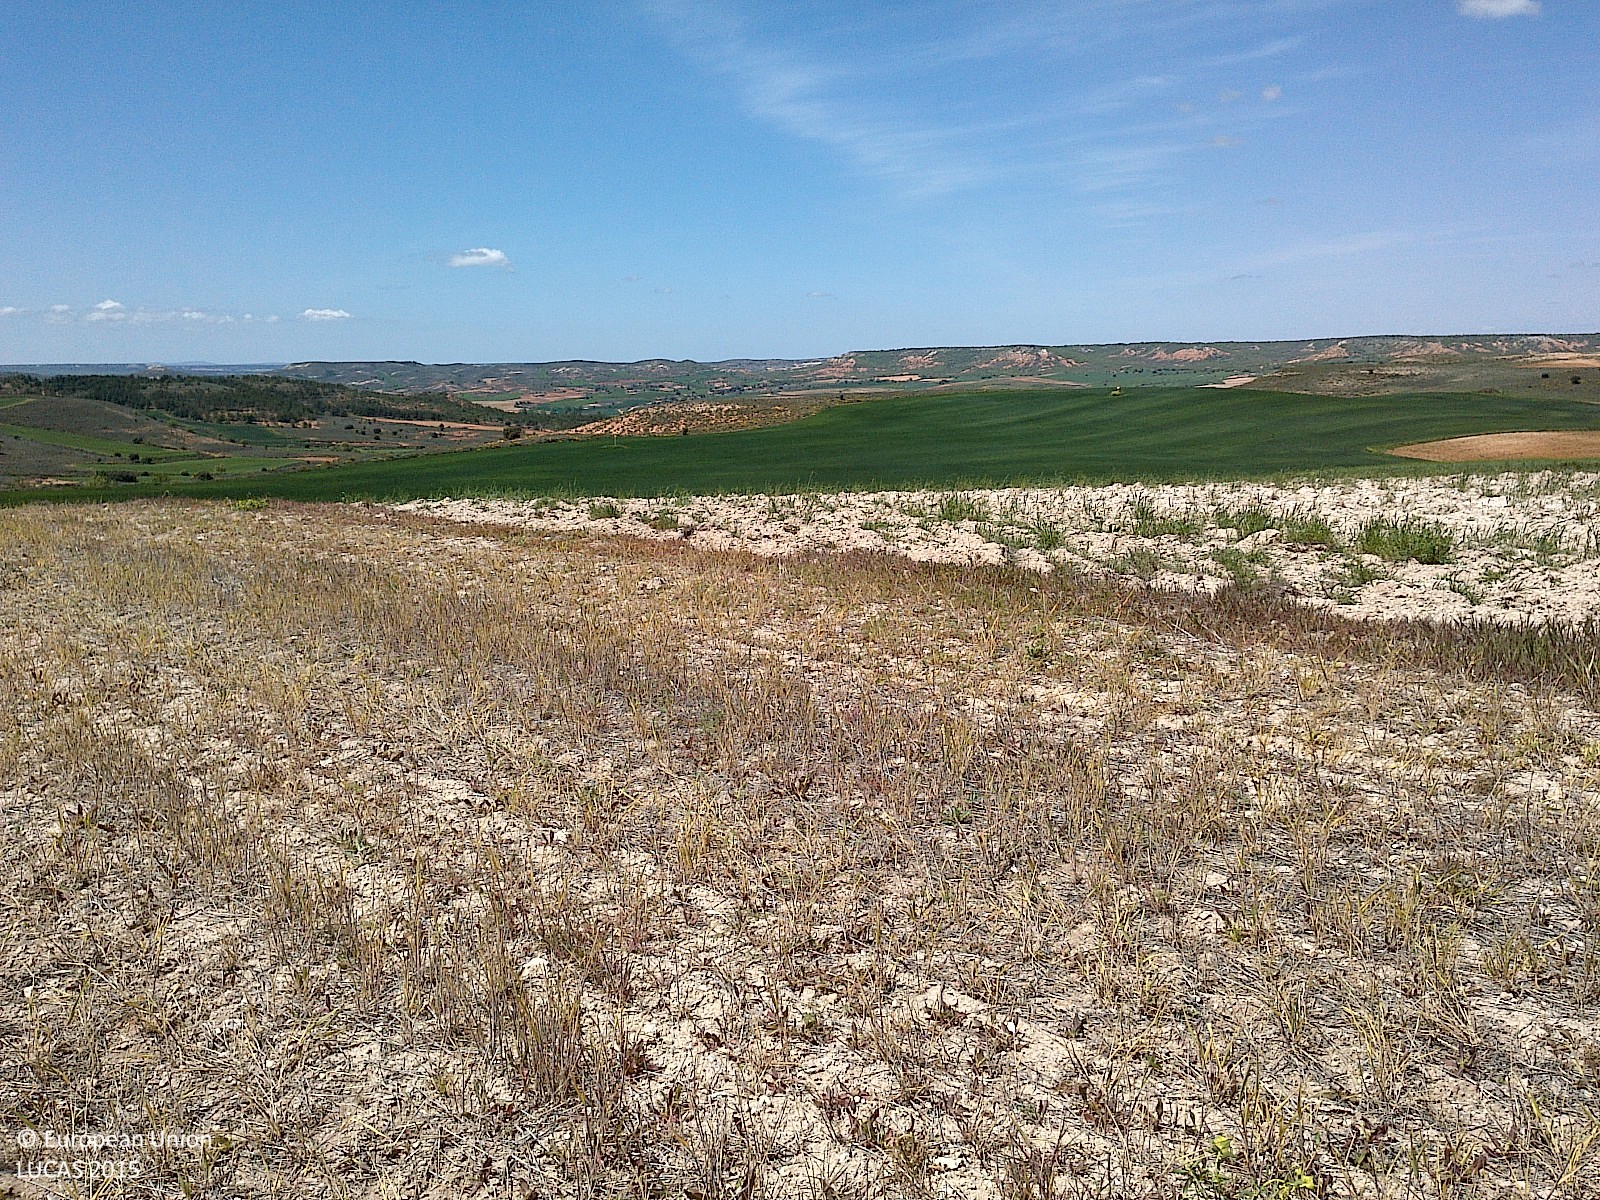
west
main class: Cropland
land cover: Barley
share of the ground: 25 - 50 %
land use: Fallow land
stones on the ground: < 10 %
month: May
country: ES
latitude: 41.6167
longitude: -3.2350
